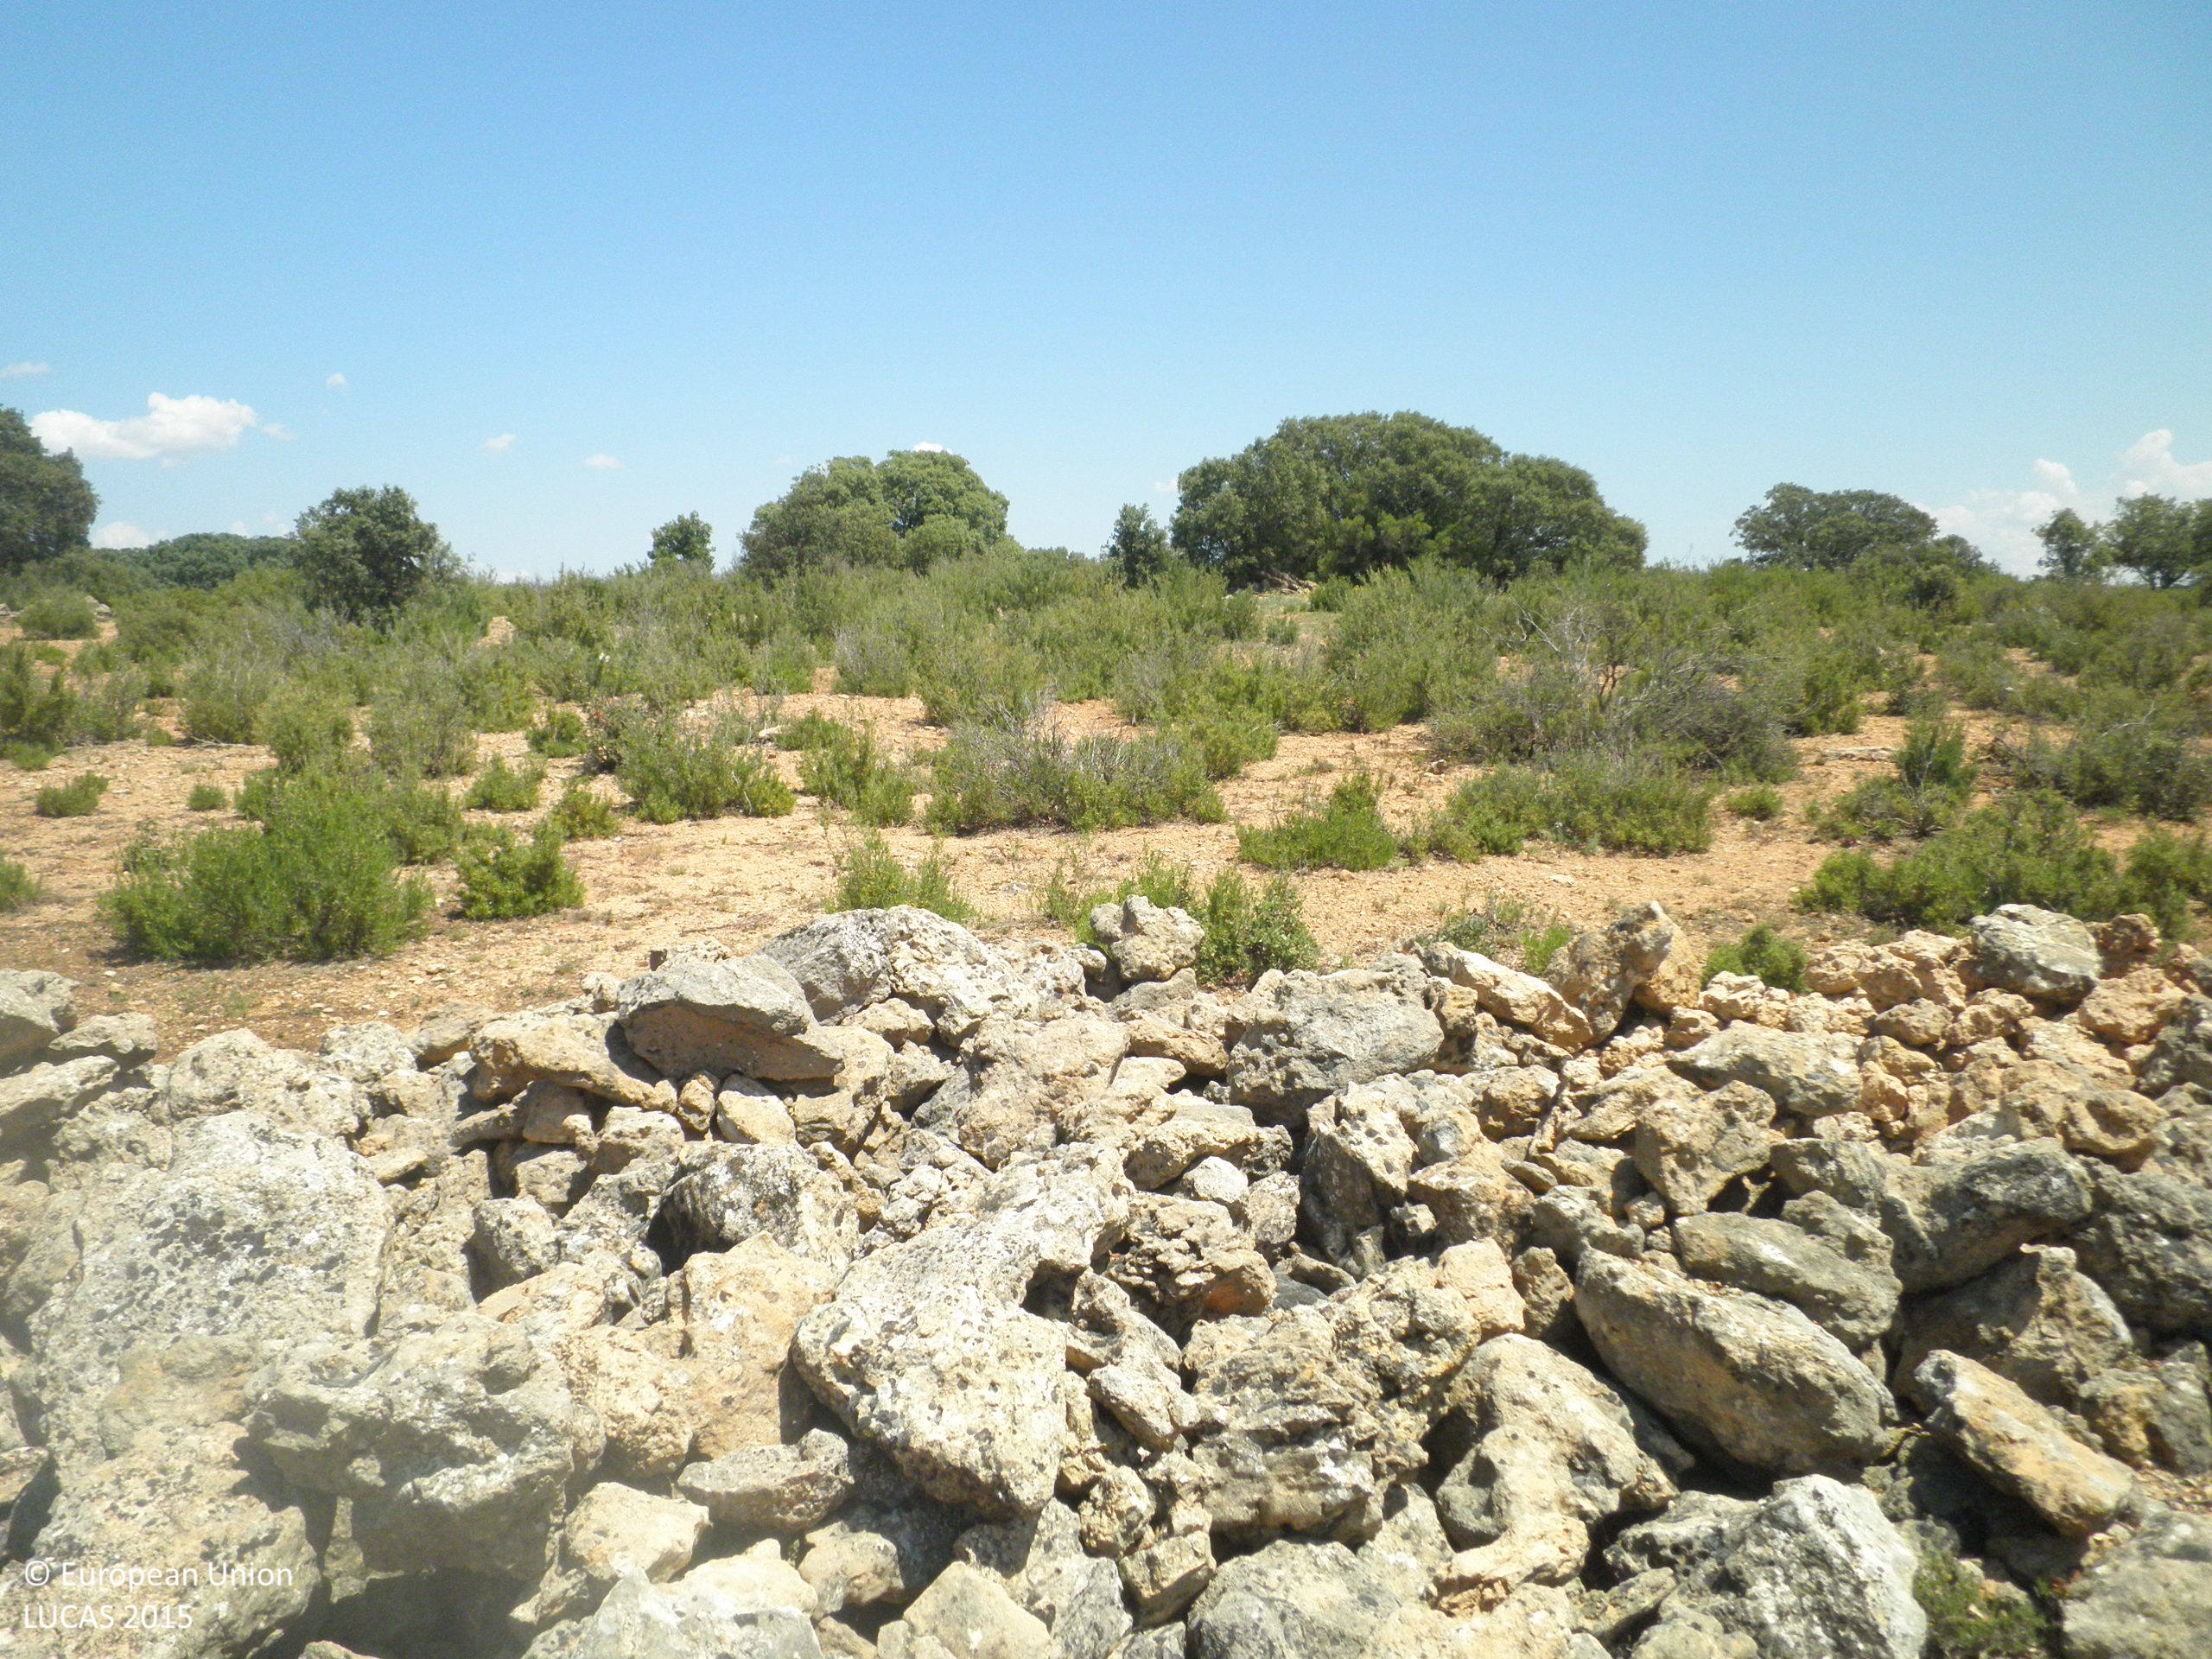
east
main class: Woodland
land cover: Broadleaved woodland
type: broadleaved evergreen forest
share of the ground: 25 - 50 %
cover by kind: unconsolidated bare surface 35 %, shrubs 30 %, broadleaved forest trees 25 %, consolidated bare surface 10 %
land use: Semi-natural and natural areas not in use
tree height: < 5 m
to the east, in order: Broadleaved woodland; Dry stone walls; Shrubland without tree cover; Shrubland with sparse tree cover; Broadleaved woodland; Spontaneously vegetated surfaces; Grass margins; Dry stone walls; Single bushes/trees; Broadleaved woodland; Spontaneously vegetated surfaces
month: June
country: ES
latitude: 39.4900
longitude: -1.7141
